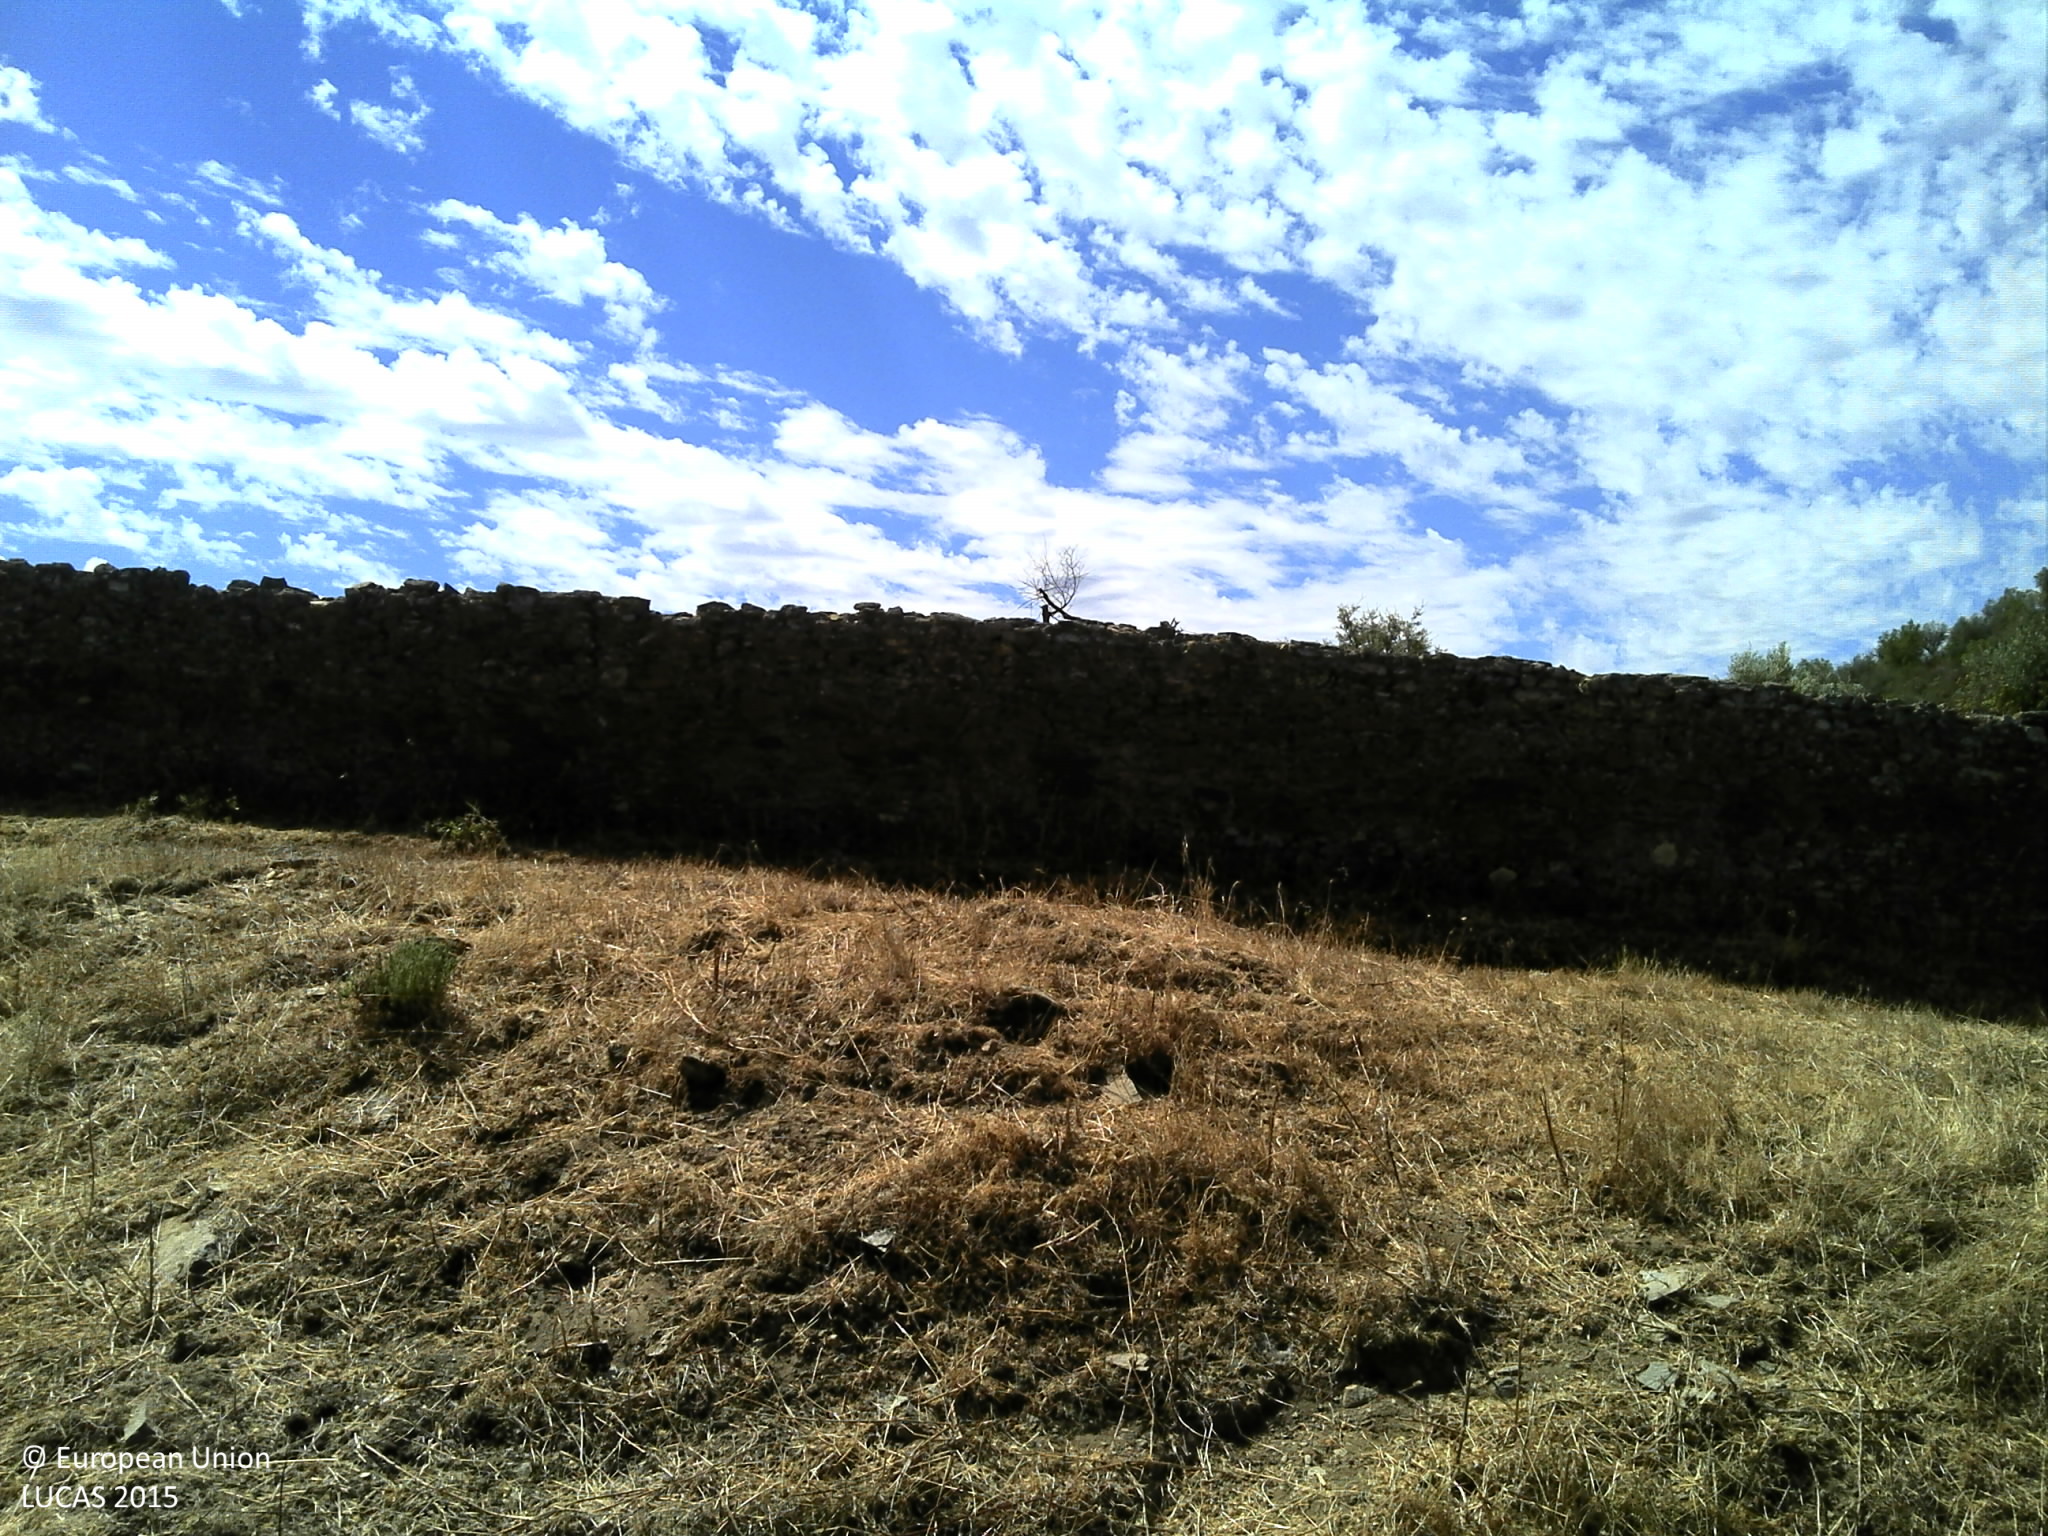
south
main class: Grassland
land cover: Grassland without tree/shrub cover
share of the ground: > 75 %
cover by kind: herbaceous plants 75 %, unconsolidated bare surface 25 %
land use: Agriculture (excluding fallow land and kitchen gardens)
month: August
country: PT
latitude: 39.5249
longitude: -7.6279
